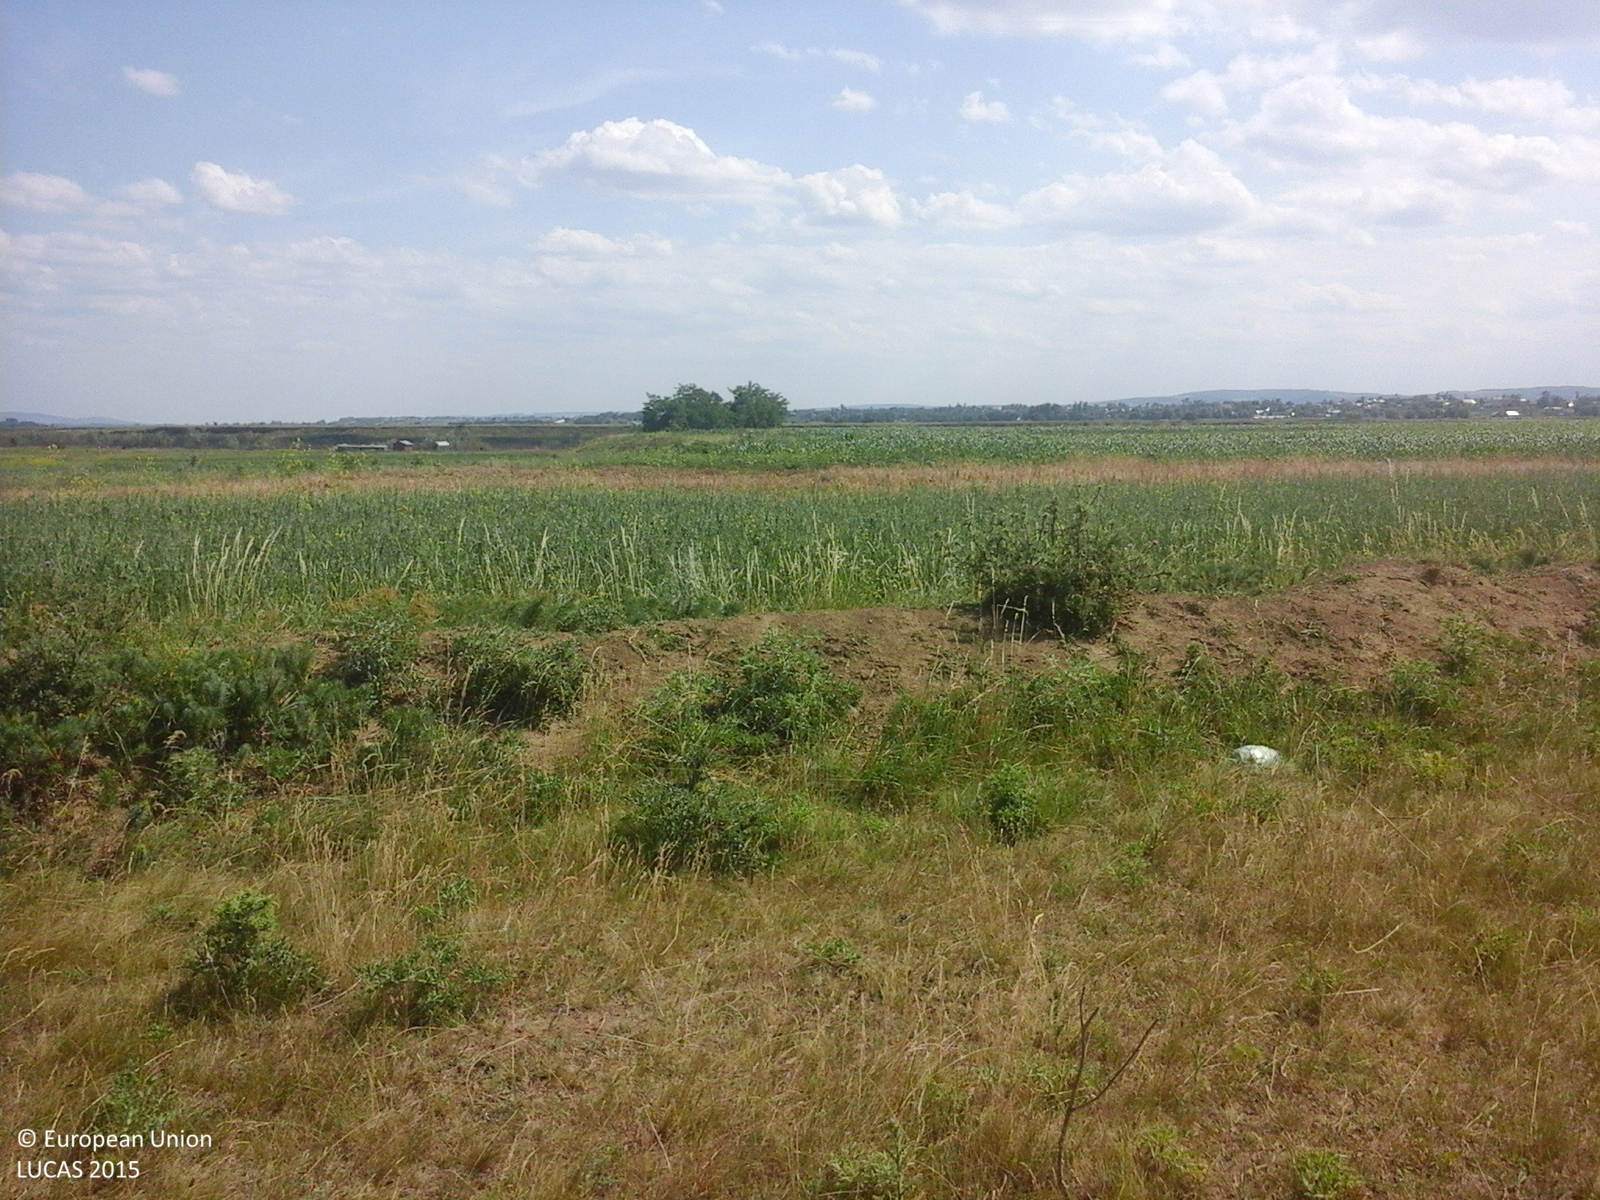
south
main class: Grassland
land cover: Grassland without tree/shrub cover
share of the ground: > 75 %
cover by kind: herbaceous plants 100 %
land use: Agriculture (excluding fallow land and kitchen gardens)
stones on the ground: < 10 %
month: June
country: RO
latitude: 47.6691
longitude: 26.4839
